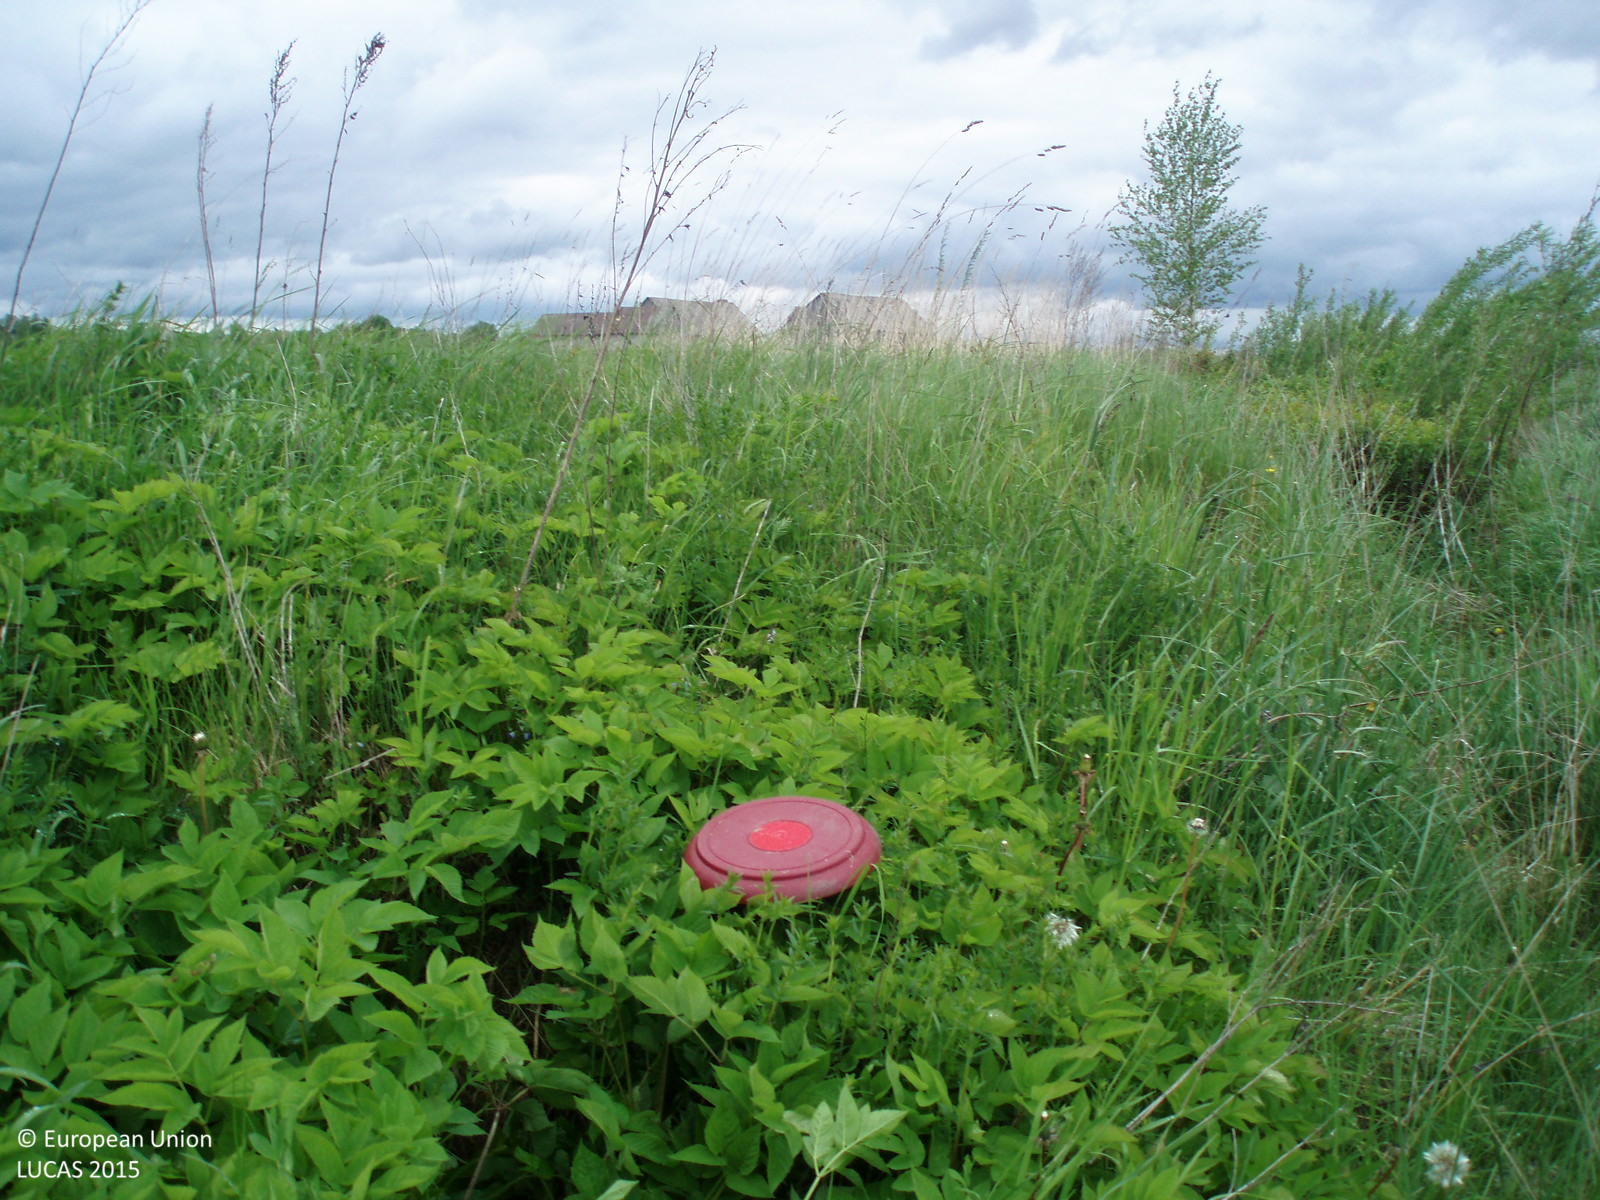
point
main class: Grassland
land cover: Grassland with sparse tree/shrub cover
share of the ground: > 75 %
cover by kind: herbaceous plants 90 %, broadleaved forest trees 5 %, shrubs 5 %
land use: Road transport
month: May
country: LT
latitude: 56.3182
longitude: 22.5239
